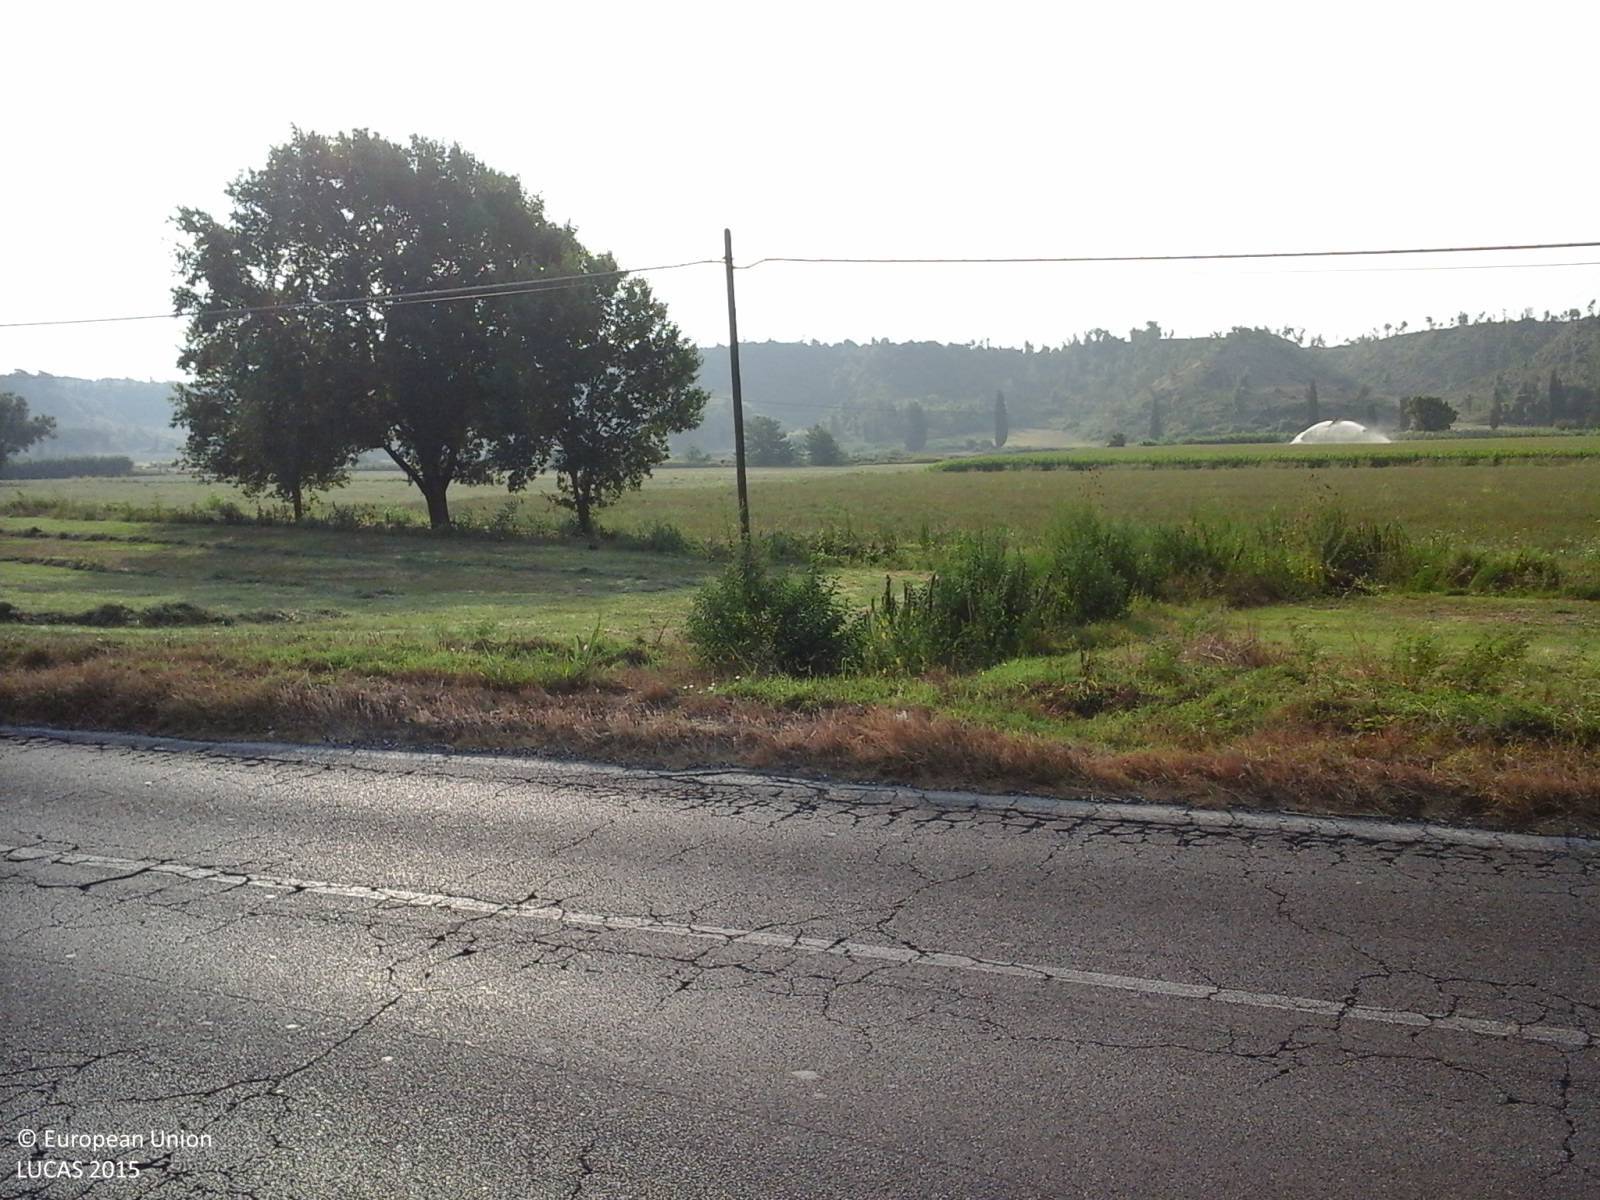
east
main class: Grassland
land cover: Grassland without tree/shrub cover
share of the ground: > 75 %
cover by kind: herbaceous plants 100 %
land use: Agriculture (excluding fallow land and kitchen gardens)
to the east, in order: Grassland without tree/shrub cover; Shruby margins; Fences; Paved roads, cycling and walking lanes; Grass margins; Lucerne; Grass margins; Electric lines; Ditches and canals; Tracks; Grass margins; Electric lines; Lucerne; Electric lines; Lucerne
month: July
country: IT
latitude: 41.9237
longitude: 12.2705
